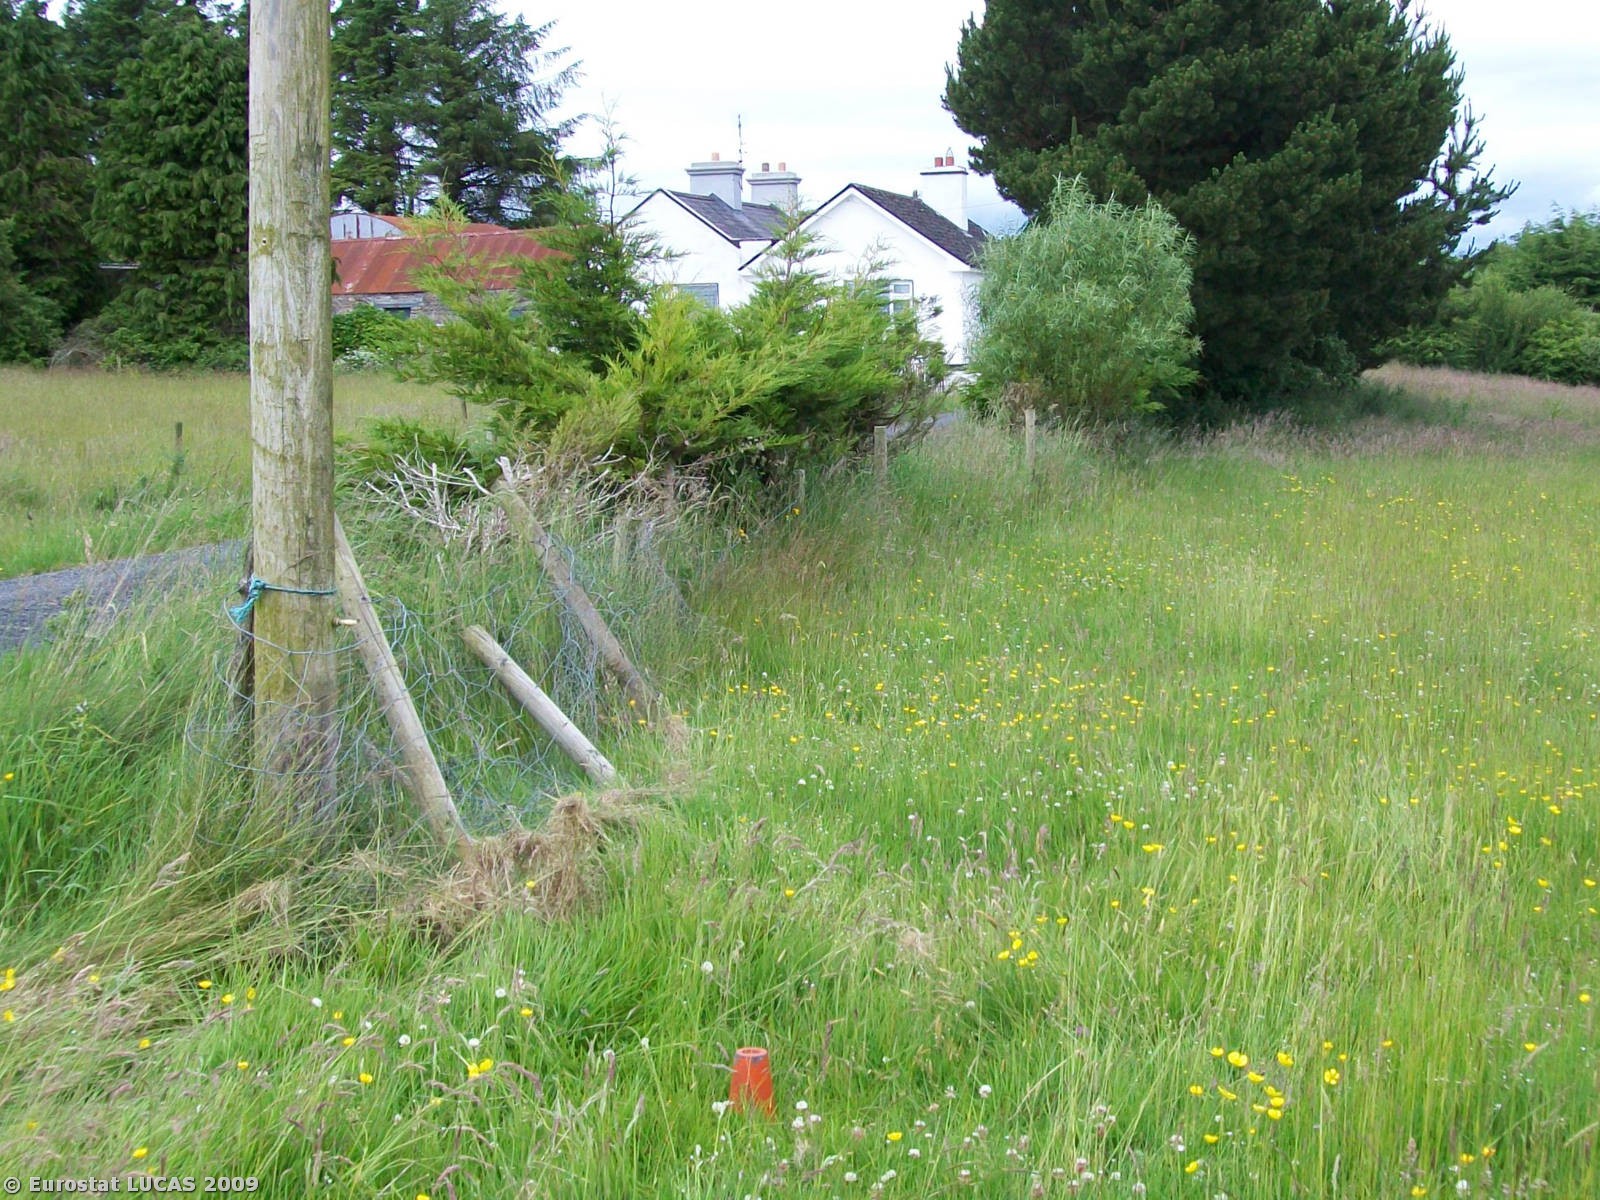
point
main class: Grassland
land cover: Grassland without tree/shrub cover
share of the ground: > 75 %
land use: Agriculture (excluding fallow land and kitchen gardens)
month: June
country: IE
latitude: 53.7808
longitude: -9.0156
